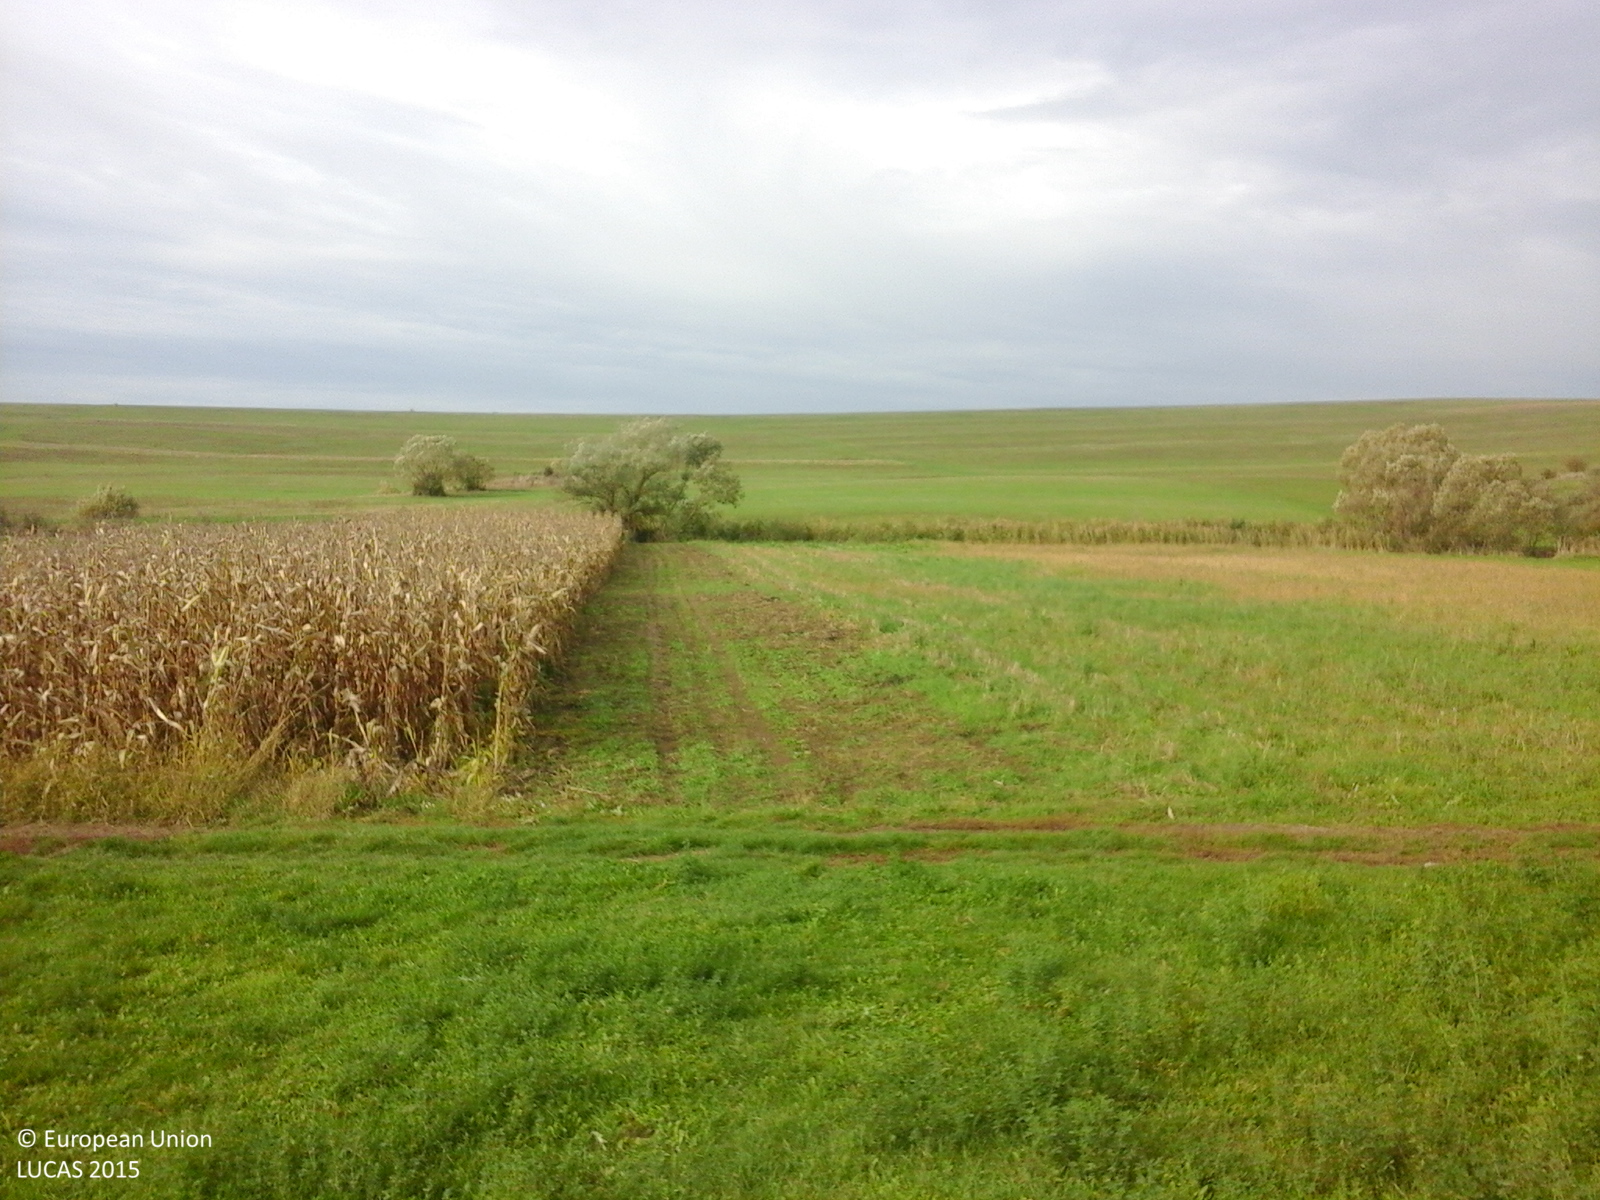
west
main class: Cropland
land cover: Lucerne
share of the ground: > 75 %
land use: Agriculture (excluding fallow land and kitchen gardens)
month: October
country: RO
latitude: 46.1991
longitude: 25.1438
